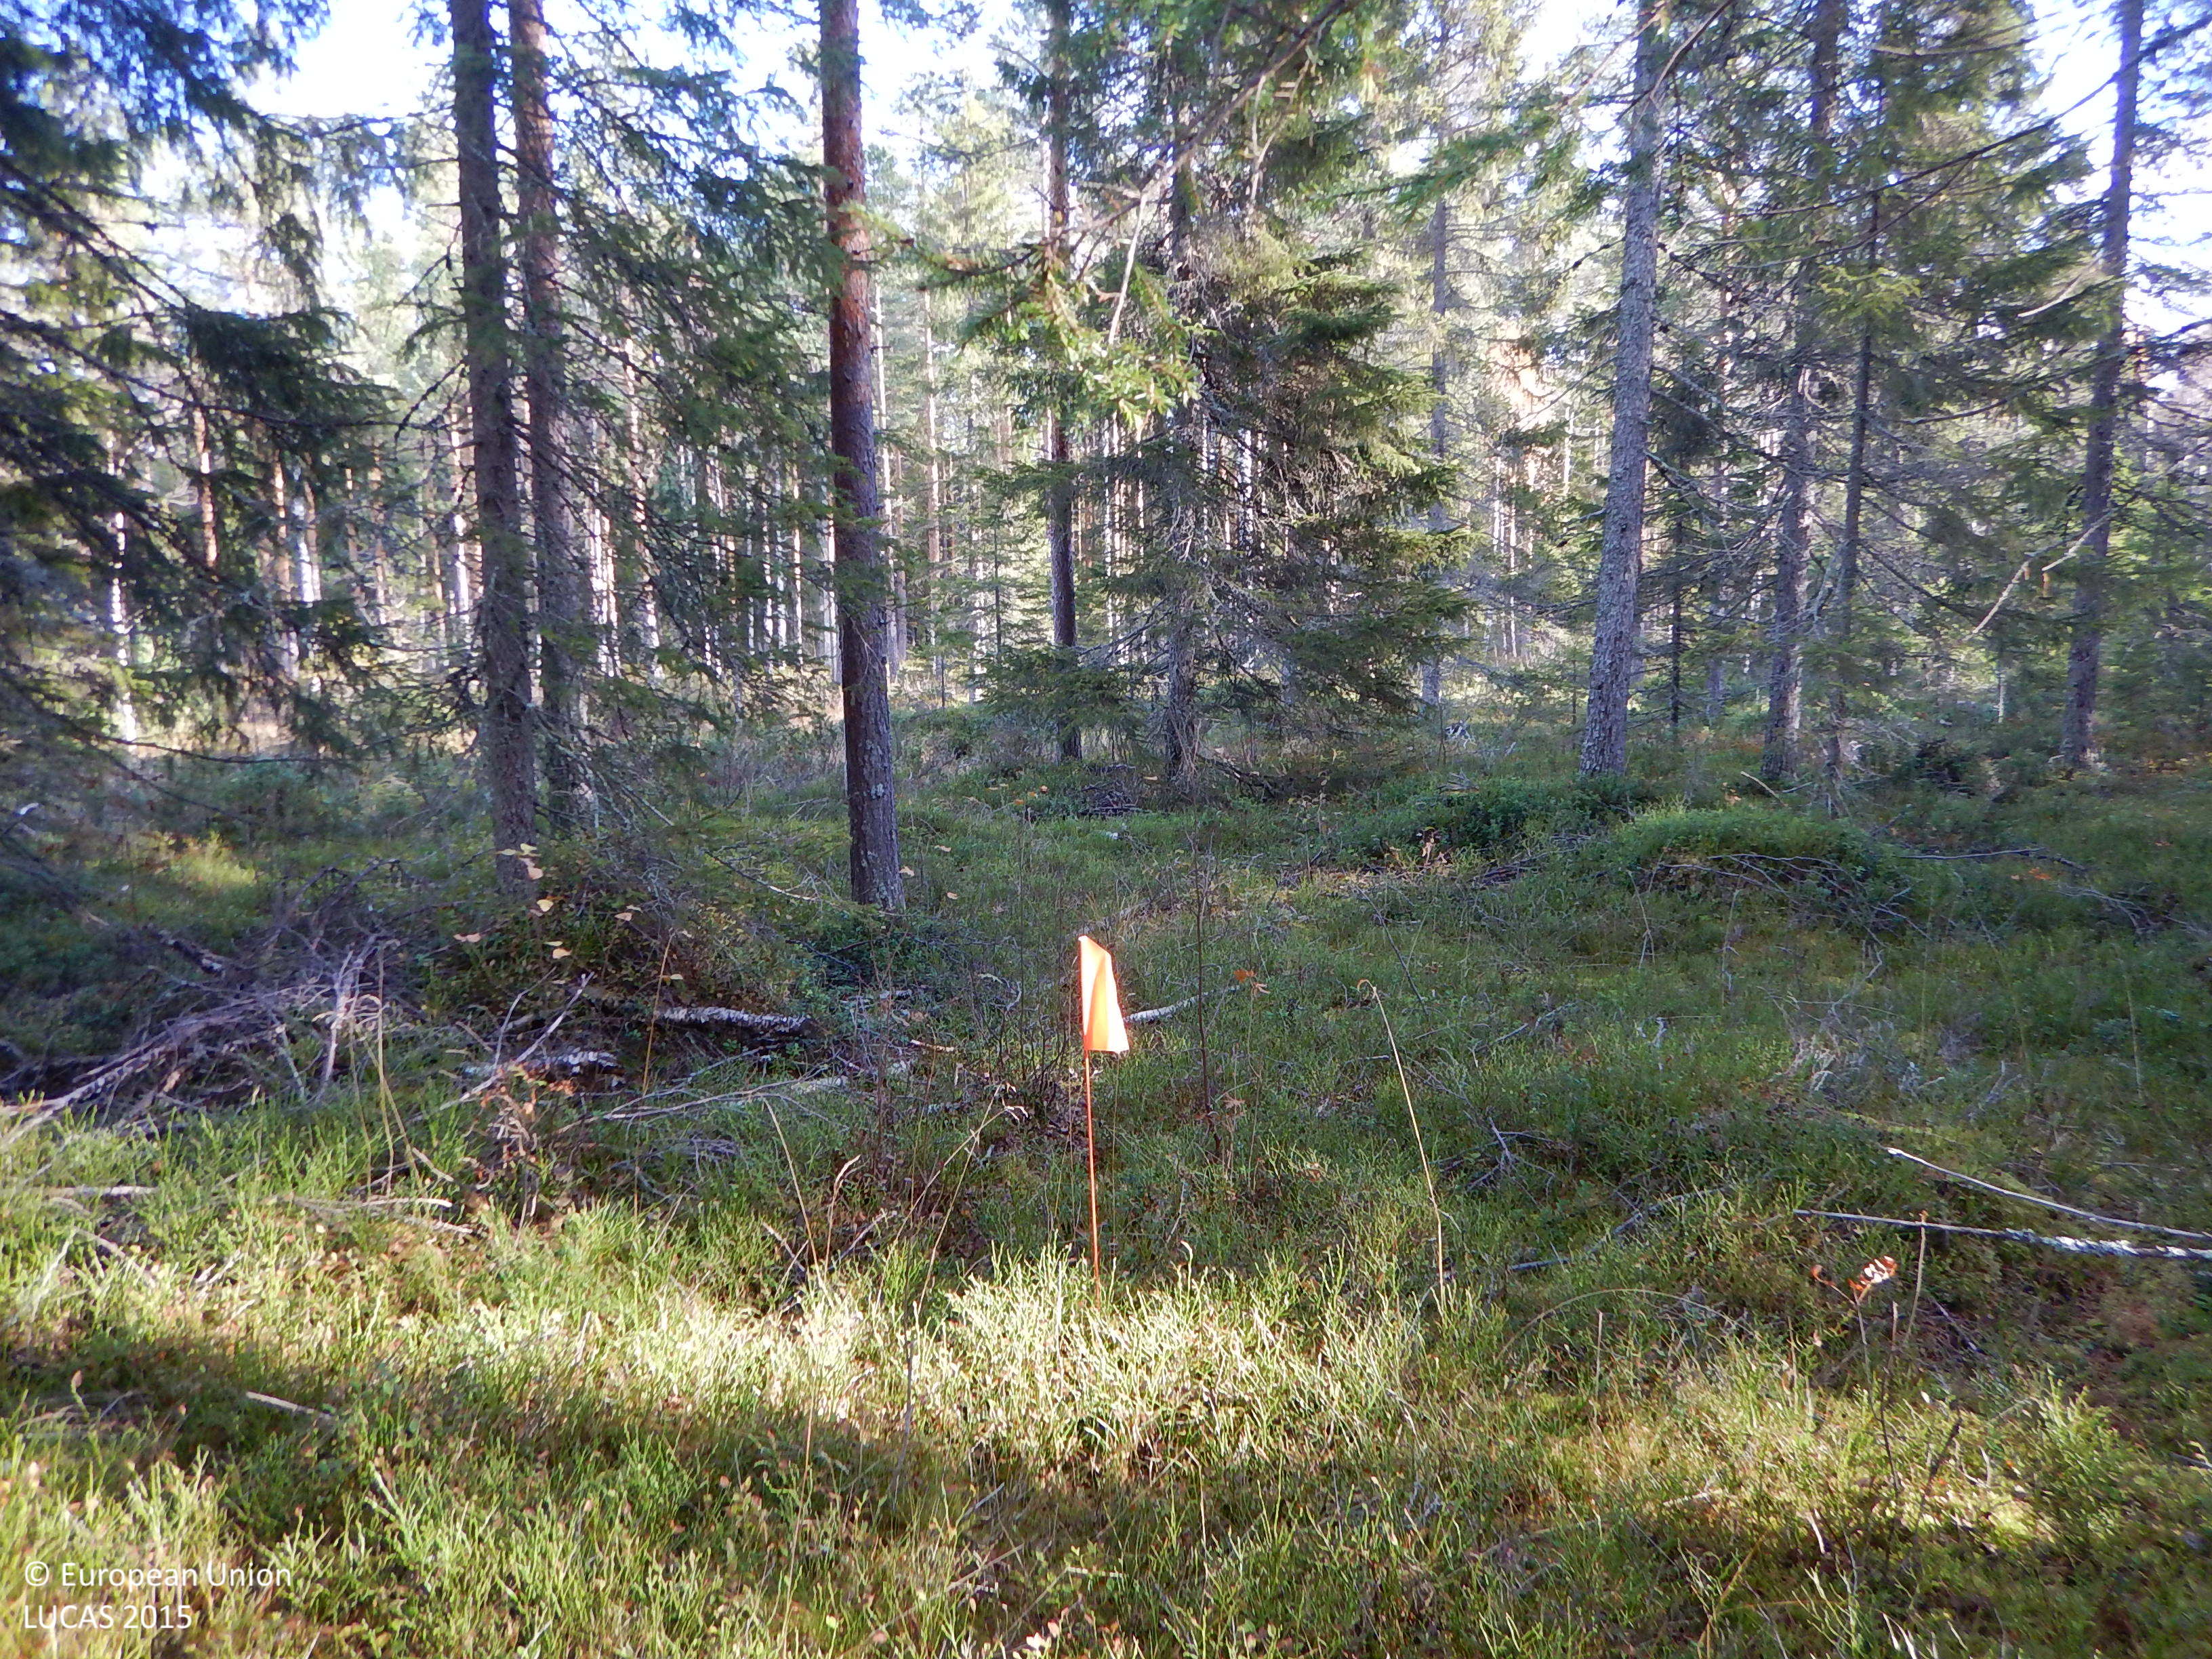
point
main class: Woodland
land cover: Other coniferous woodland
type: boreal forest
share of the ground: 50 - 75 %
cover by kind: coniferous forest trees 70 %, shrubs 15 %, lichens and mosses 10 %, herbaceous plants 5 %
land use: Forestry
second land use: Amenities, museums, leisure
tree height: > 5 m
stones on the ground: < 10 %
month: October
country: SE
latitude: 64.9672
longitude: 20.9686
